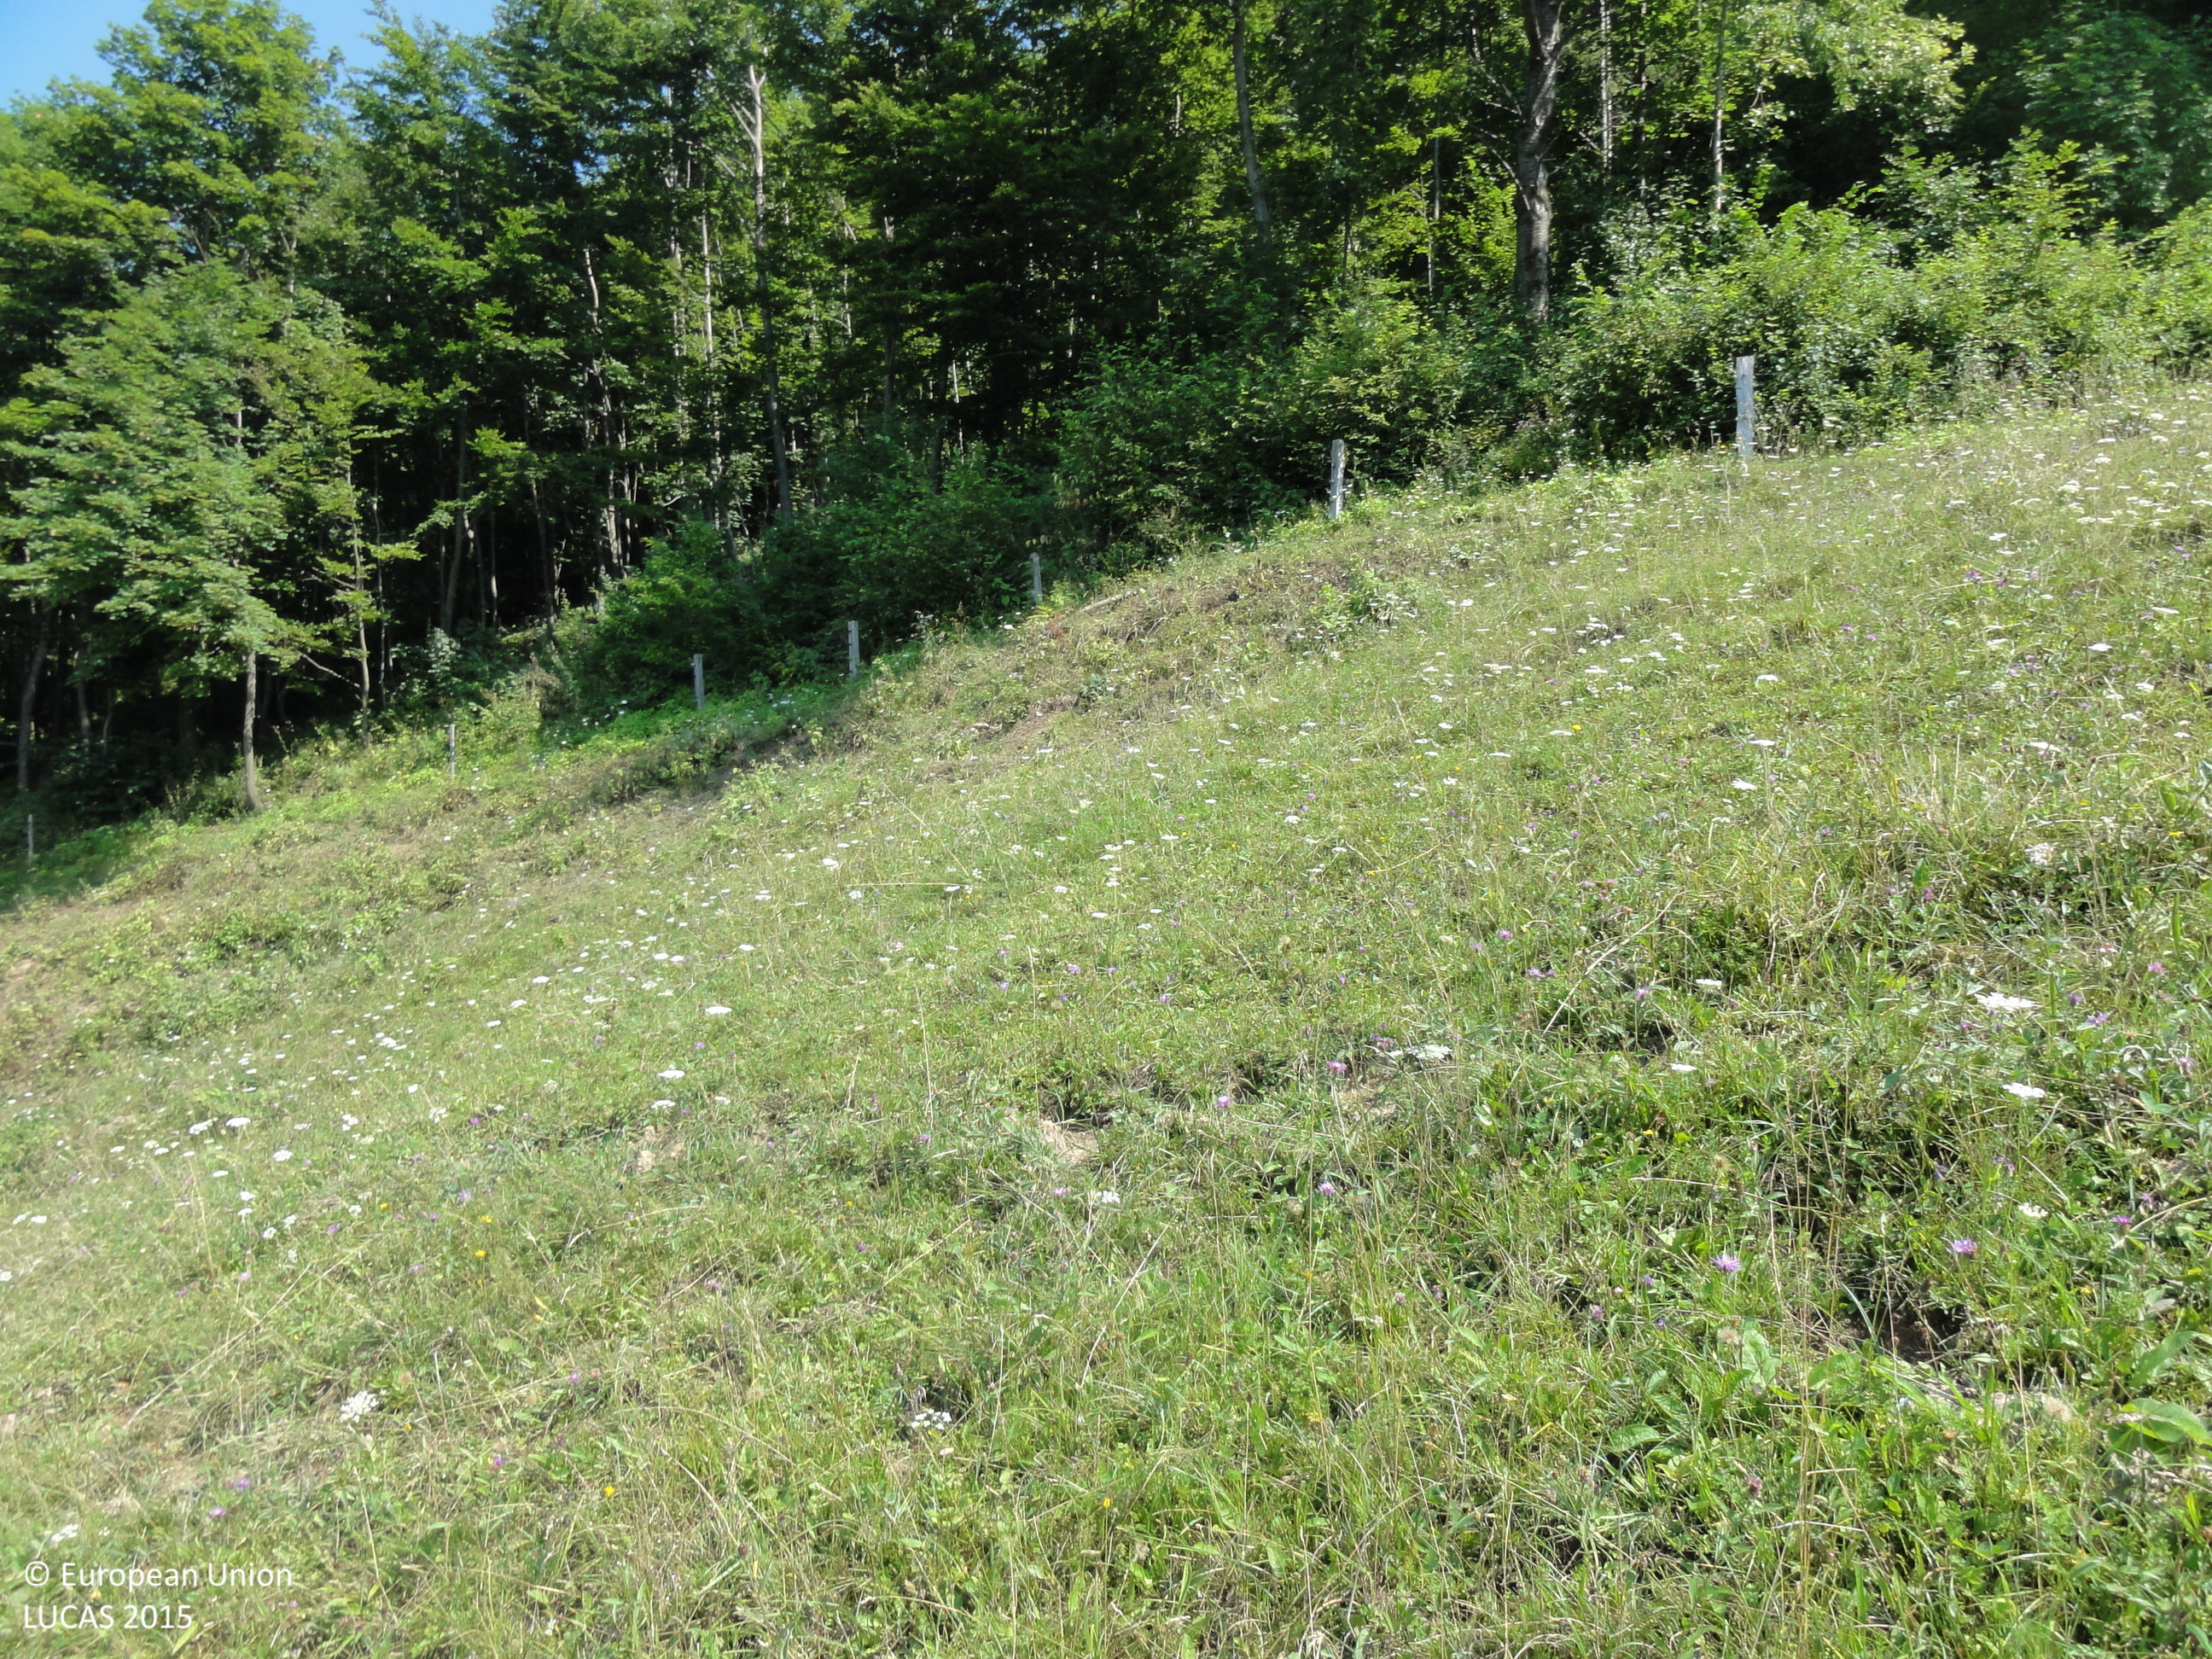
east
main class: Grassland
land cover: Grassland without tree/shrub cover
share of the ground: > 75 %
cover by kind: herbaceous plants 100 %
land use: Agriculture (excluding fallow land and kitchen gardens)
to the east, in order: Grassland without tree/shrub cover; Fences; Shrubland with sparse tree cover; Broadleaved woodland; Shrubland with sparse tree cover; Grassland with sparse tree/shrub cover
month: August
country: SI
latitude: 46.1568
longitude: 15.4753
